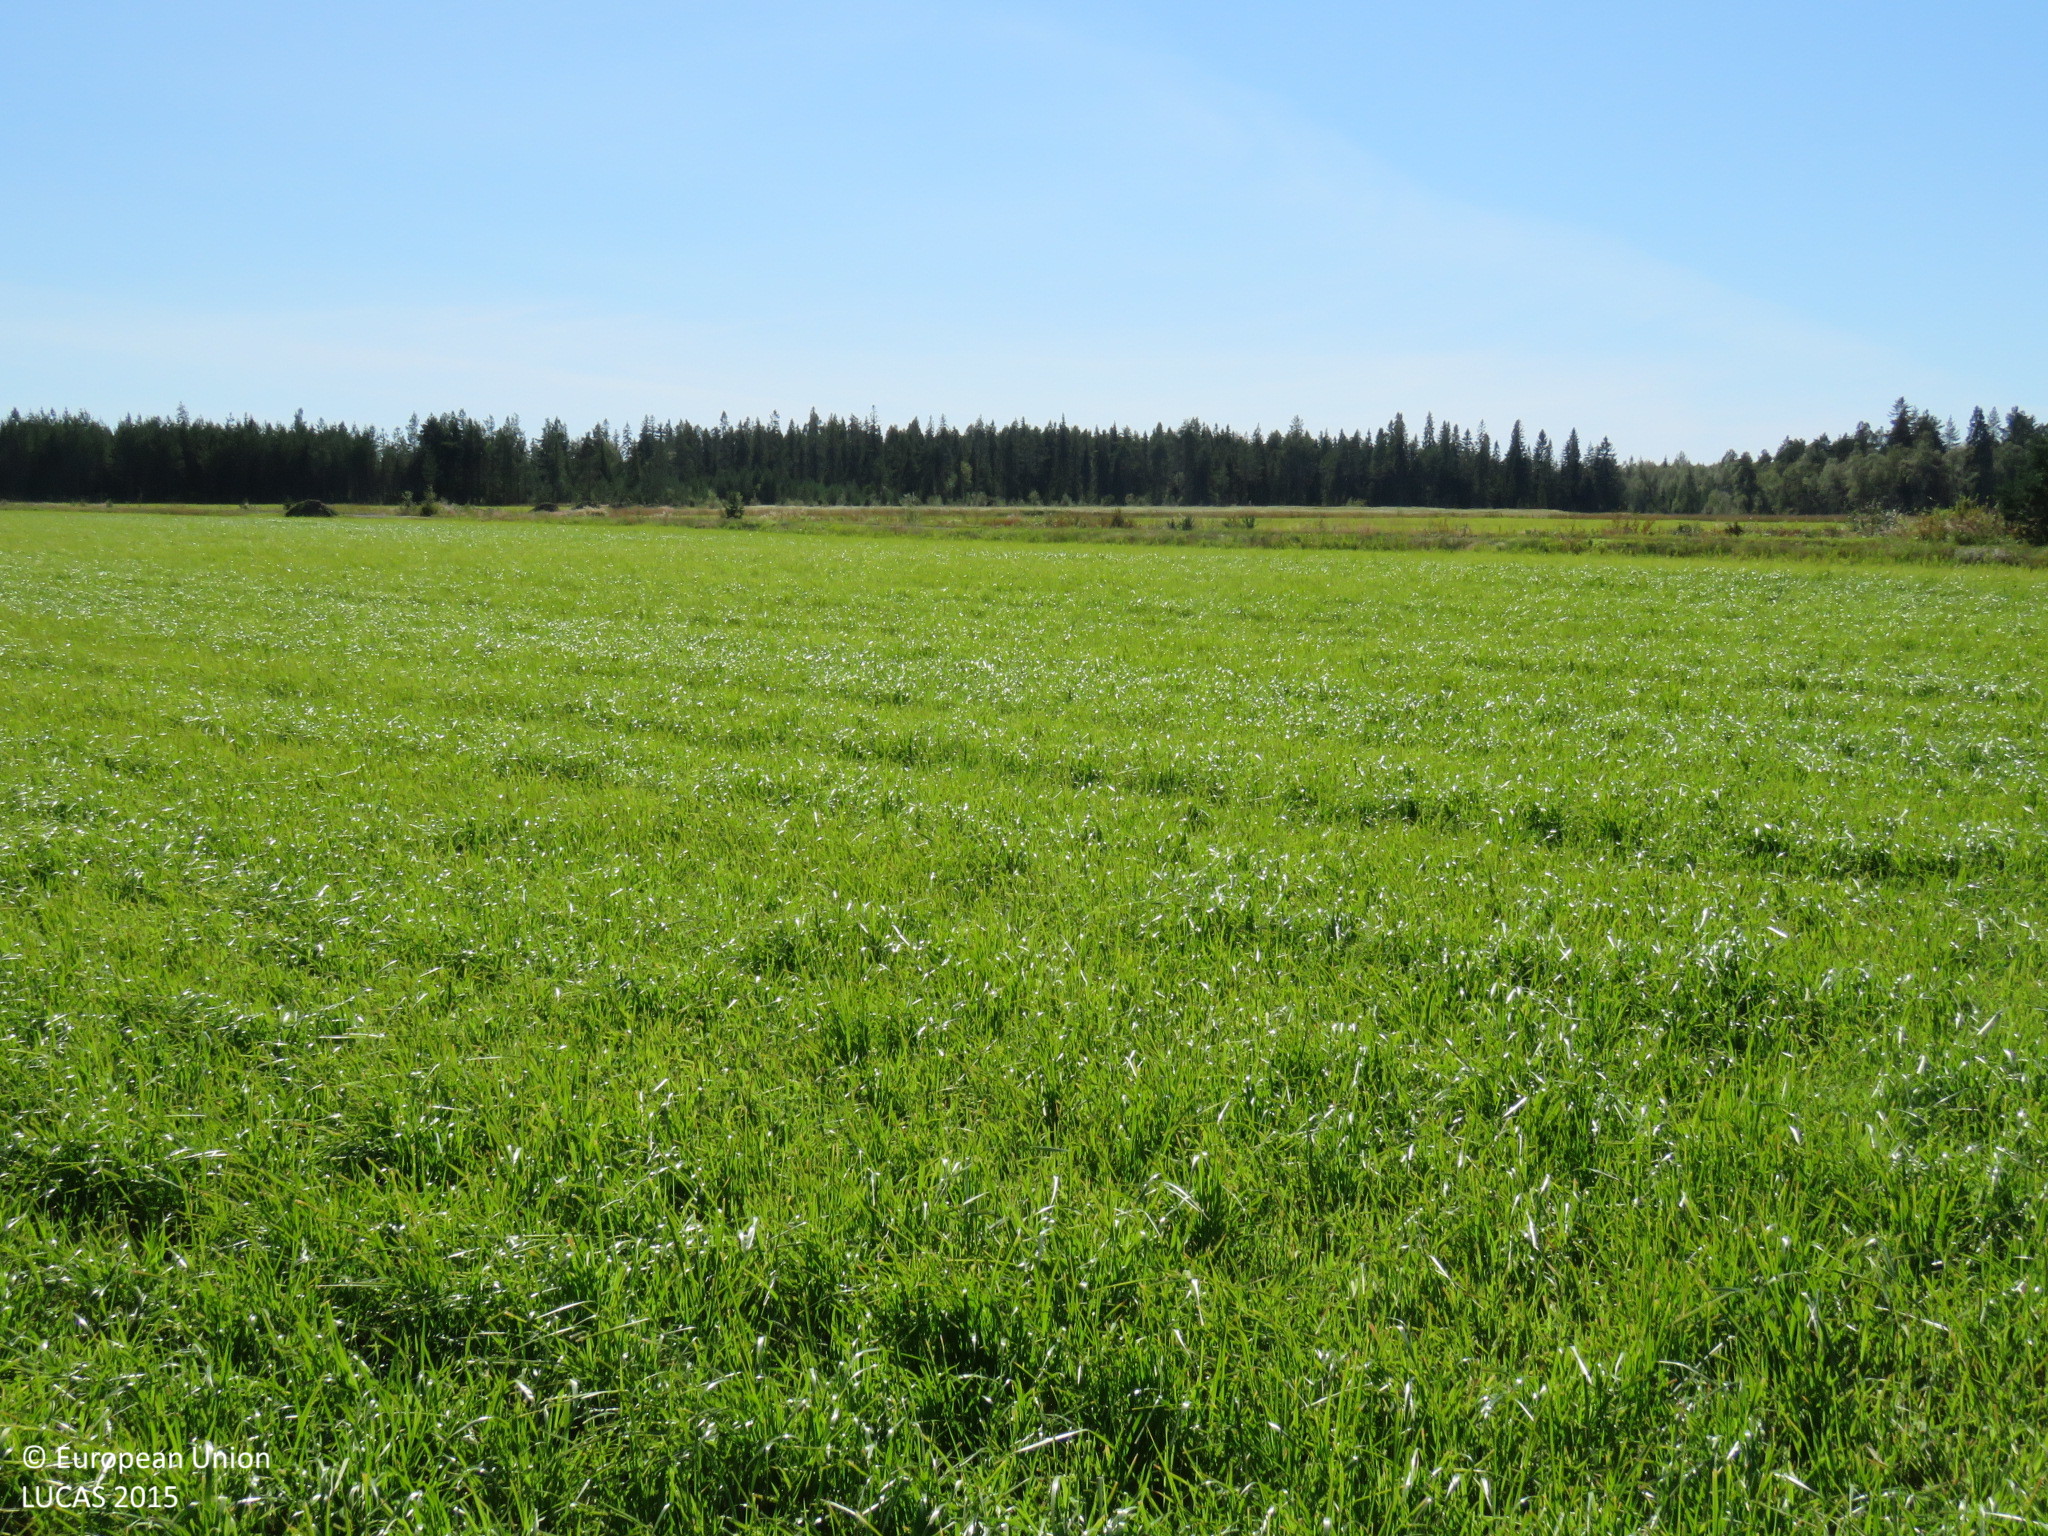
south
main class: Cropland
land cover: Temporary grasslands
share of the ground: > 75 %
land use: Agriculture (excluding fallow land and kitchen gardens)
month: August
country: FI
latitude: 65.0255
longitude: 24.8219
